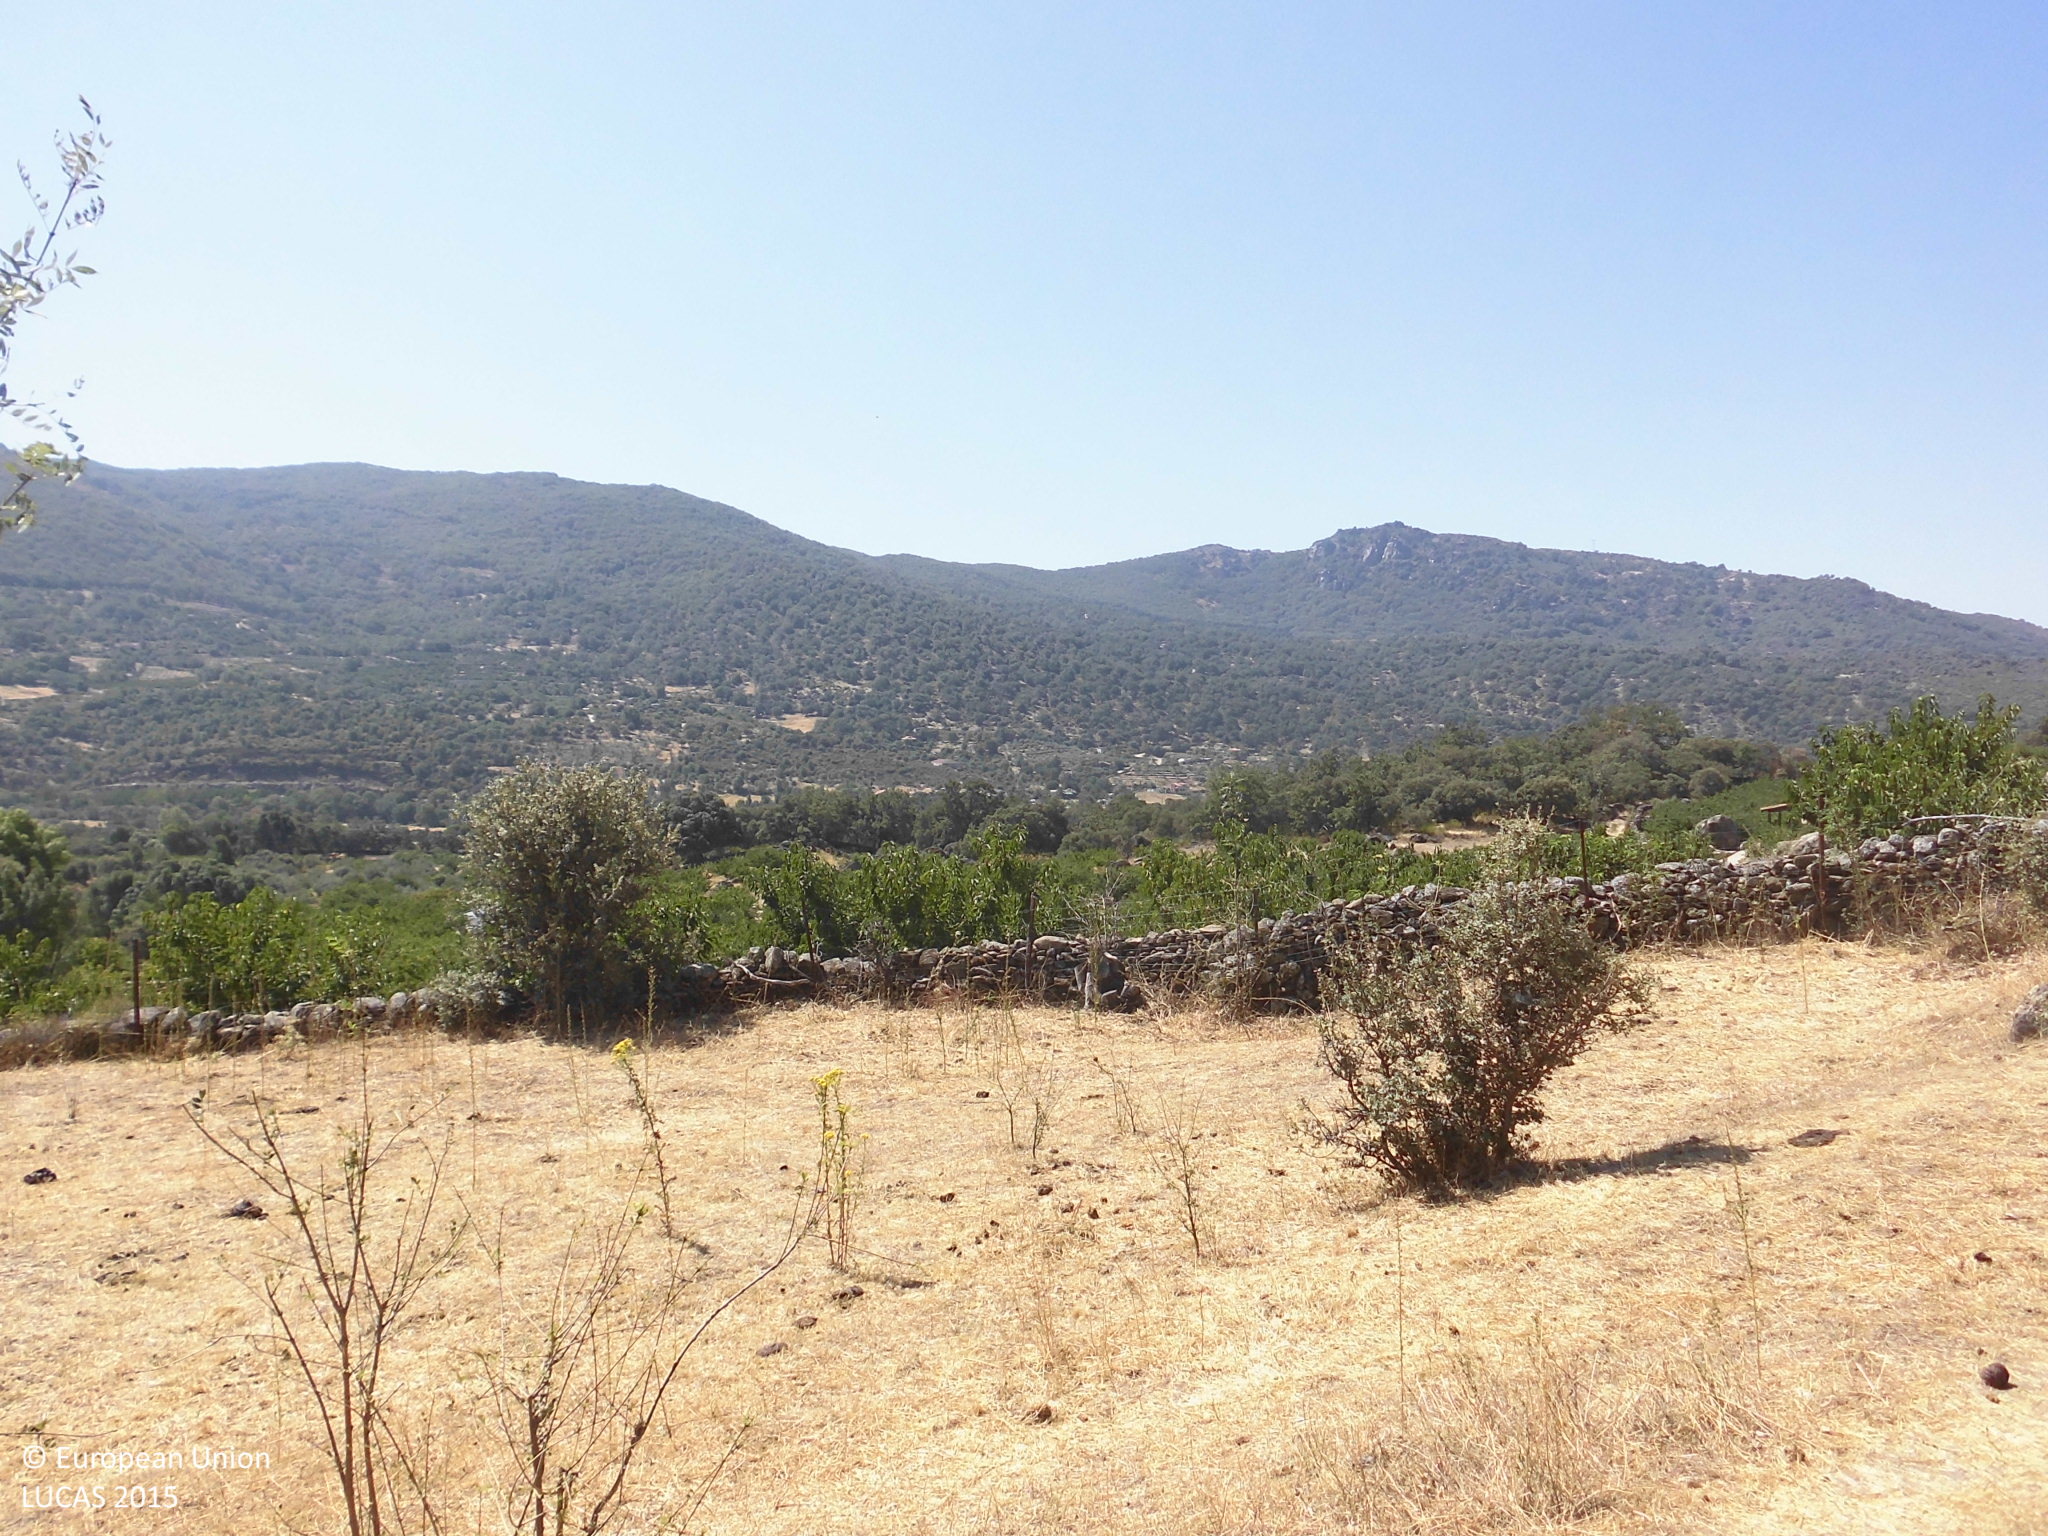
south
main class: Woodland
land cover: Broadleaved woodland
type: thermophilous deciduous forest
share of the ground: 10 - 25 %
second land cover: Grassland without tree/shrub cover
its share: > 75 %
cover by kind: herbaceous plants 90 %, broadleaved forest trees 10 %
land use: Forestry
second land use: Agriculture (excluding fallow land and kitchen gardens)
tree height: > 5 m
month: July
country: ES
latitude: 40.1093
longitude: -5.9672
